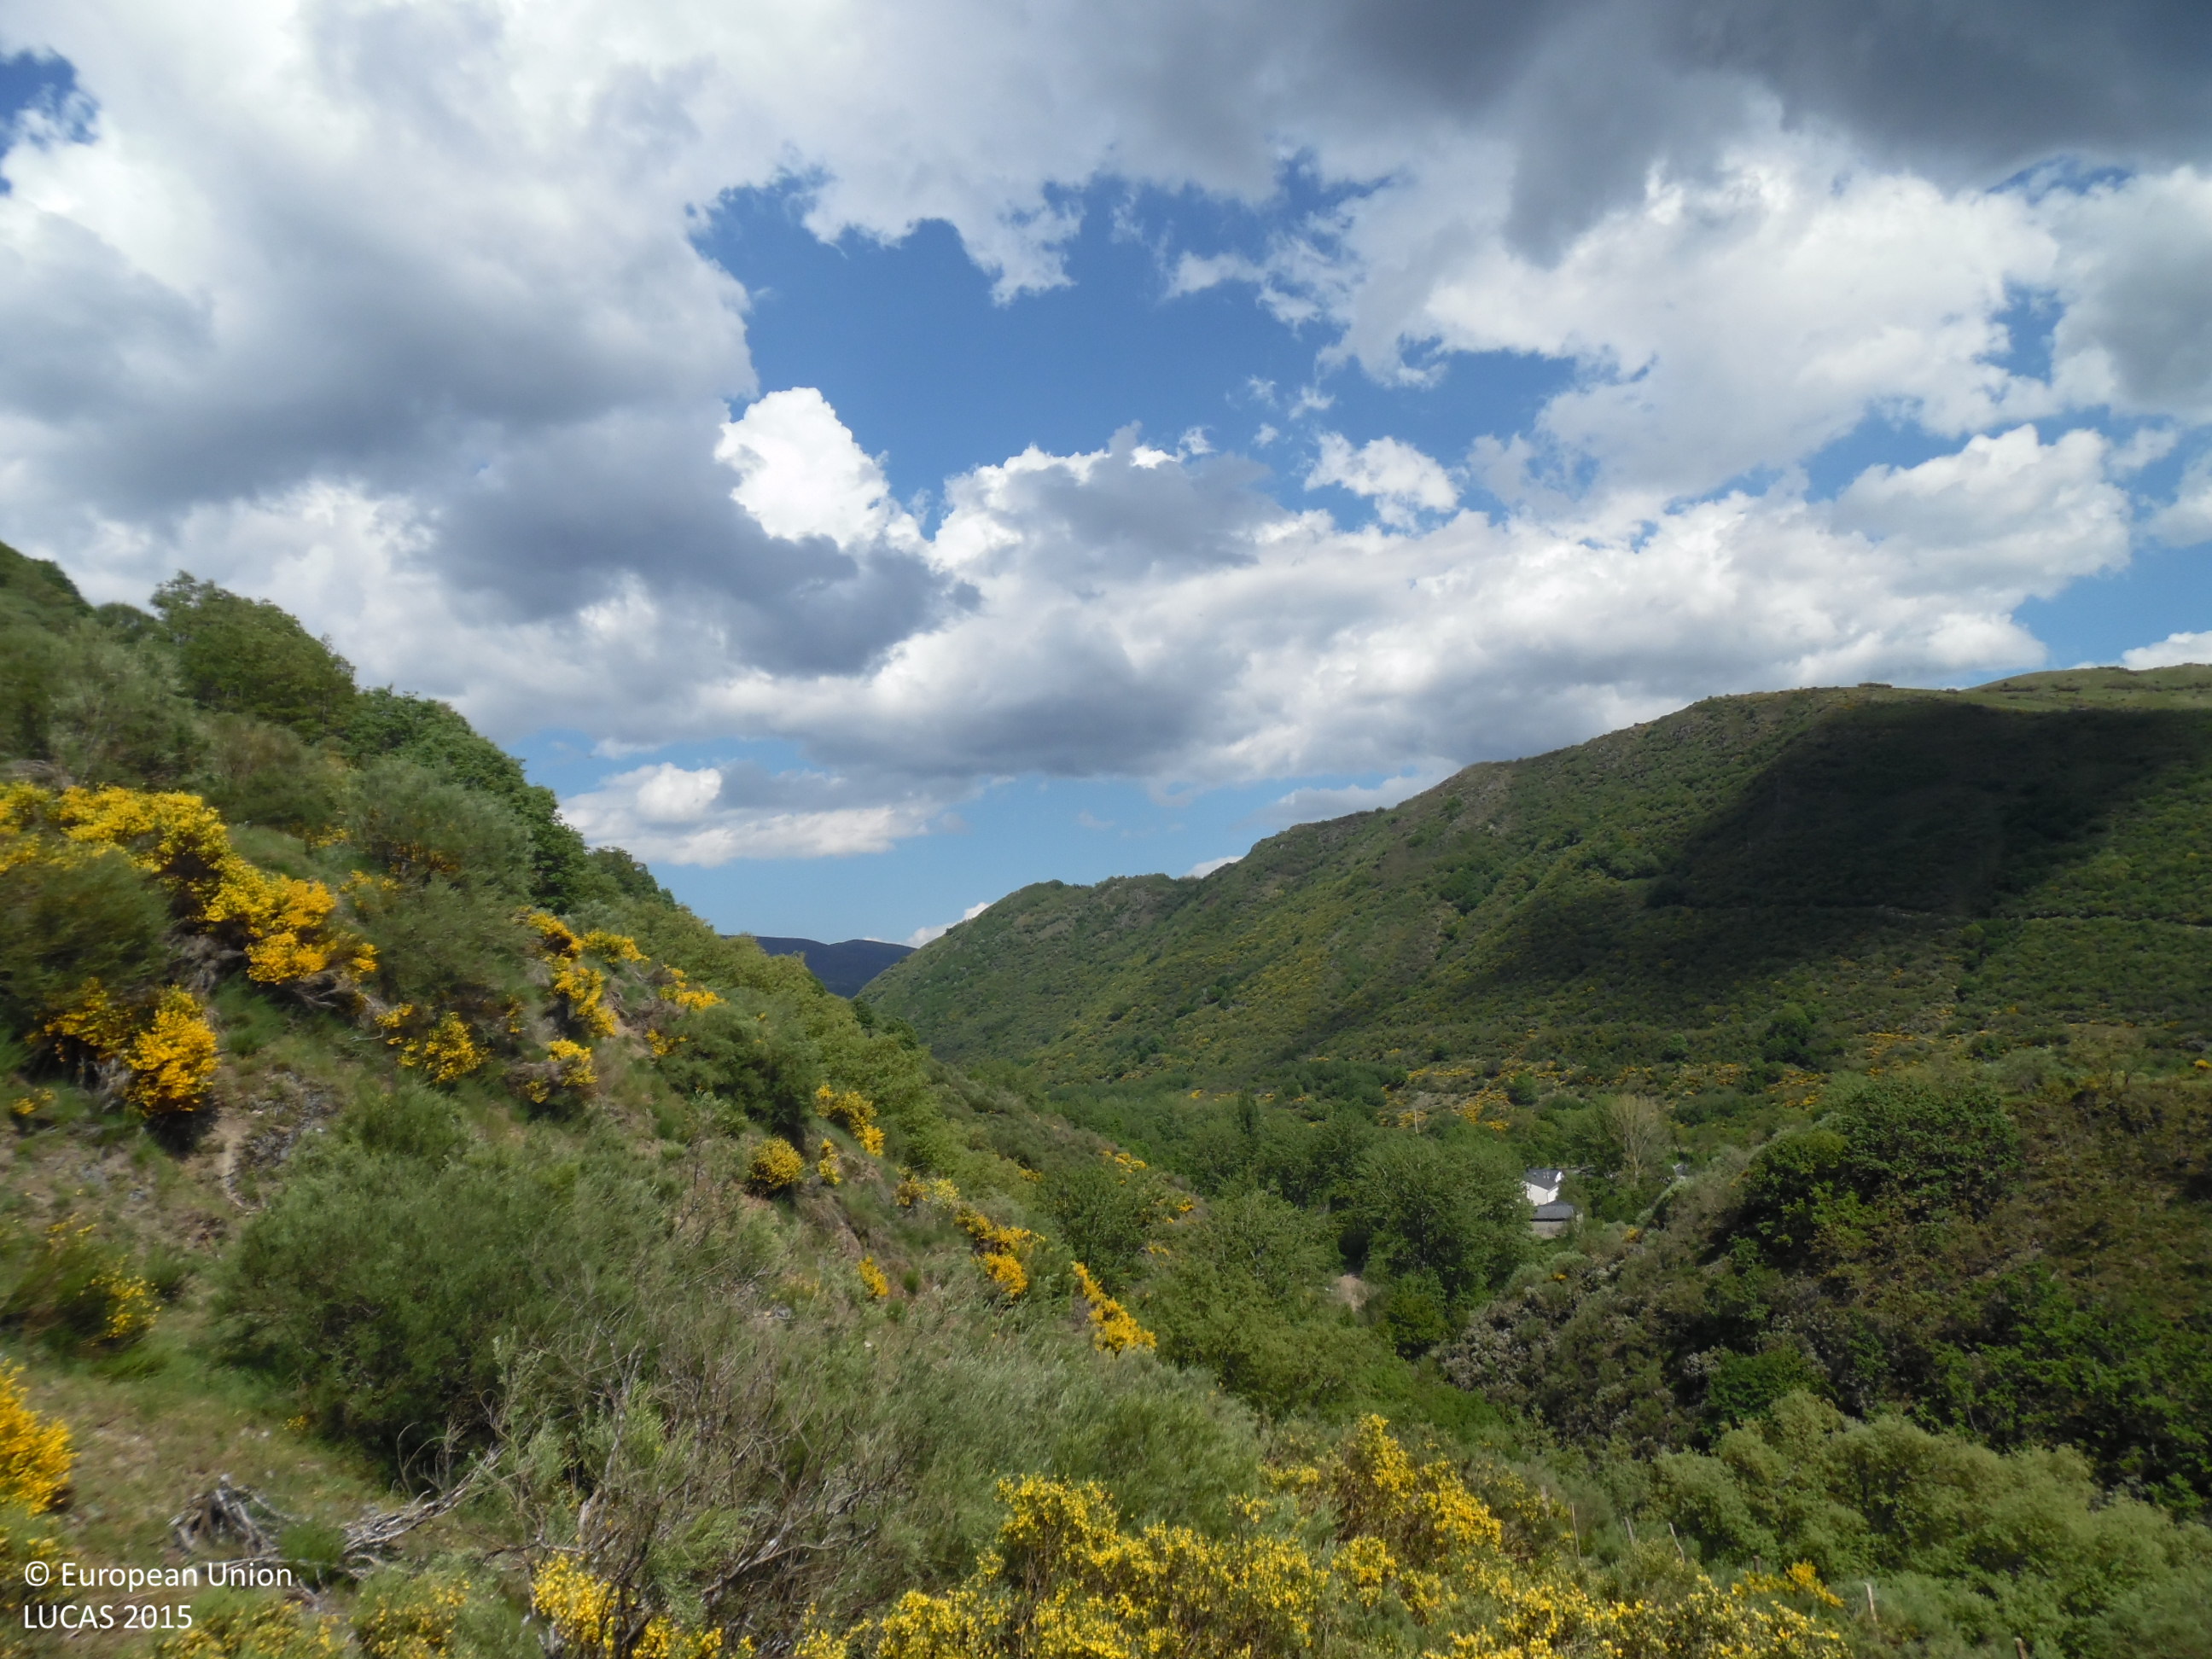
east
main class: Shrubland
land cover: Shrubland without tree cover
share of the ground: > 75 %
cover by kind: shrubs 100 %
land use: Semi-natural and natural areas not in use
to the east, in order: Shrubland without tree cover
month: May
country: ES
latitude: 42.8890
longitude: -6.1667
